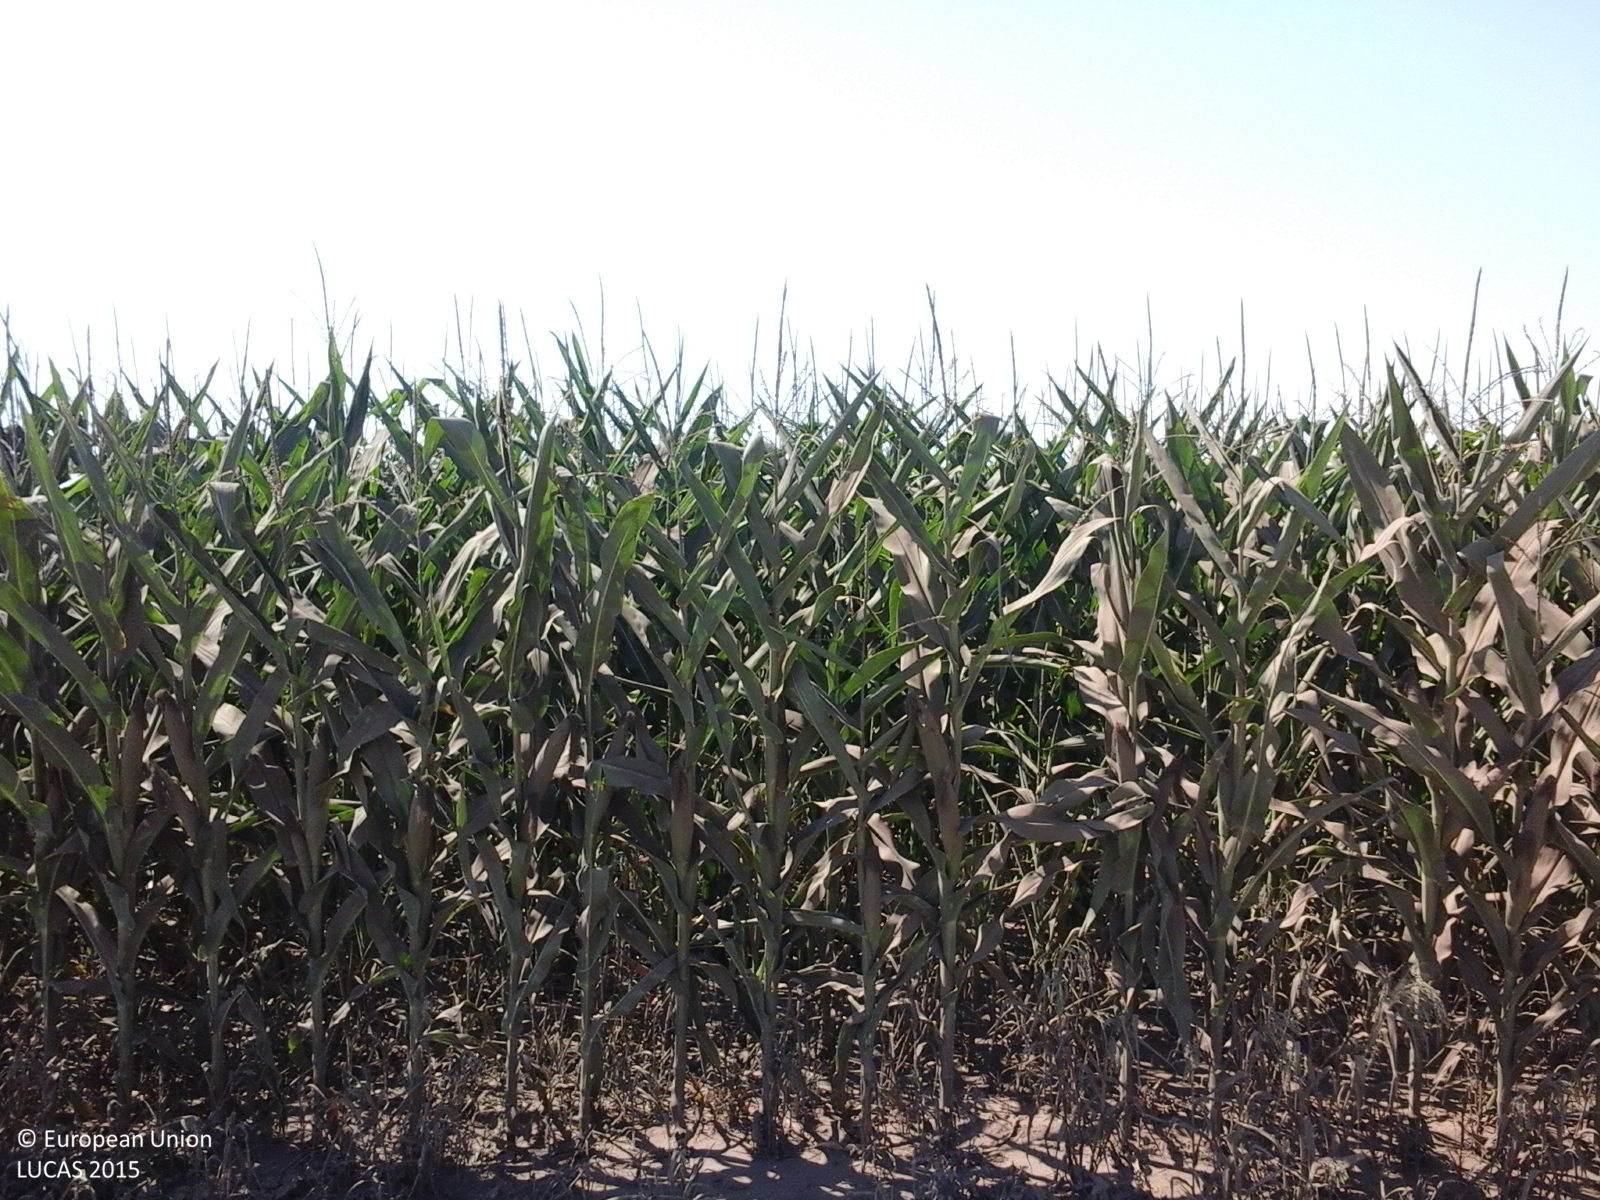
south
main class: Cropland
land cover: Maize
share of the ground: > 75 %
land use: Agriculture (excluding fallow land and kitchen gardens)
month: July
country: RO
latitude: 45.0218
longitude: 27.2875
